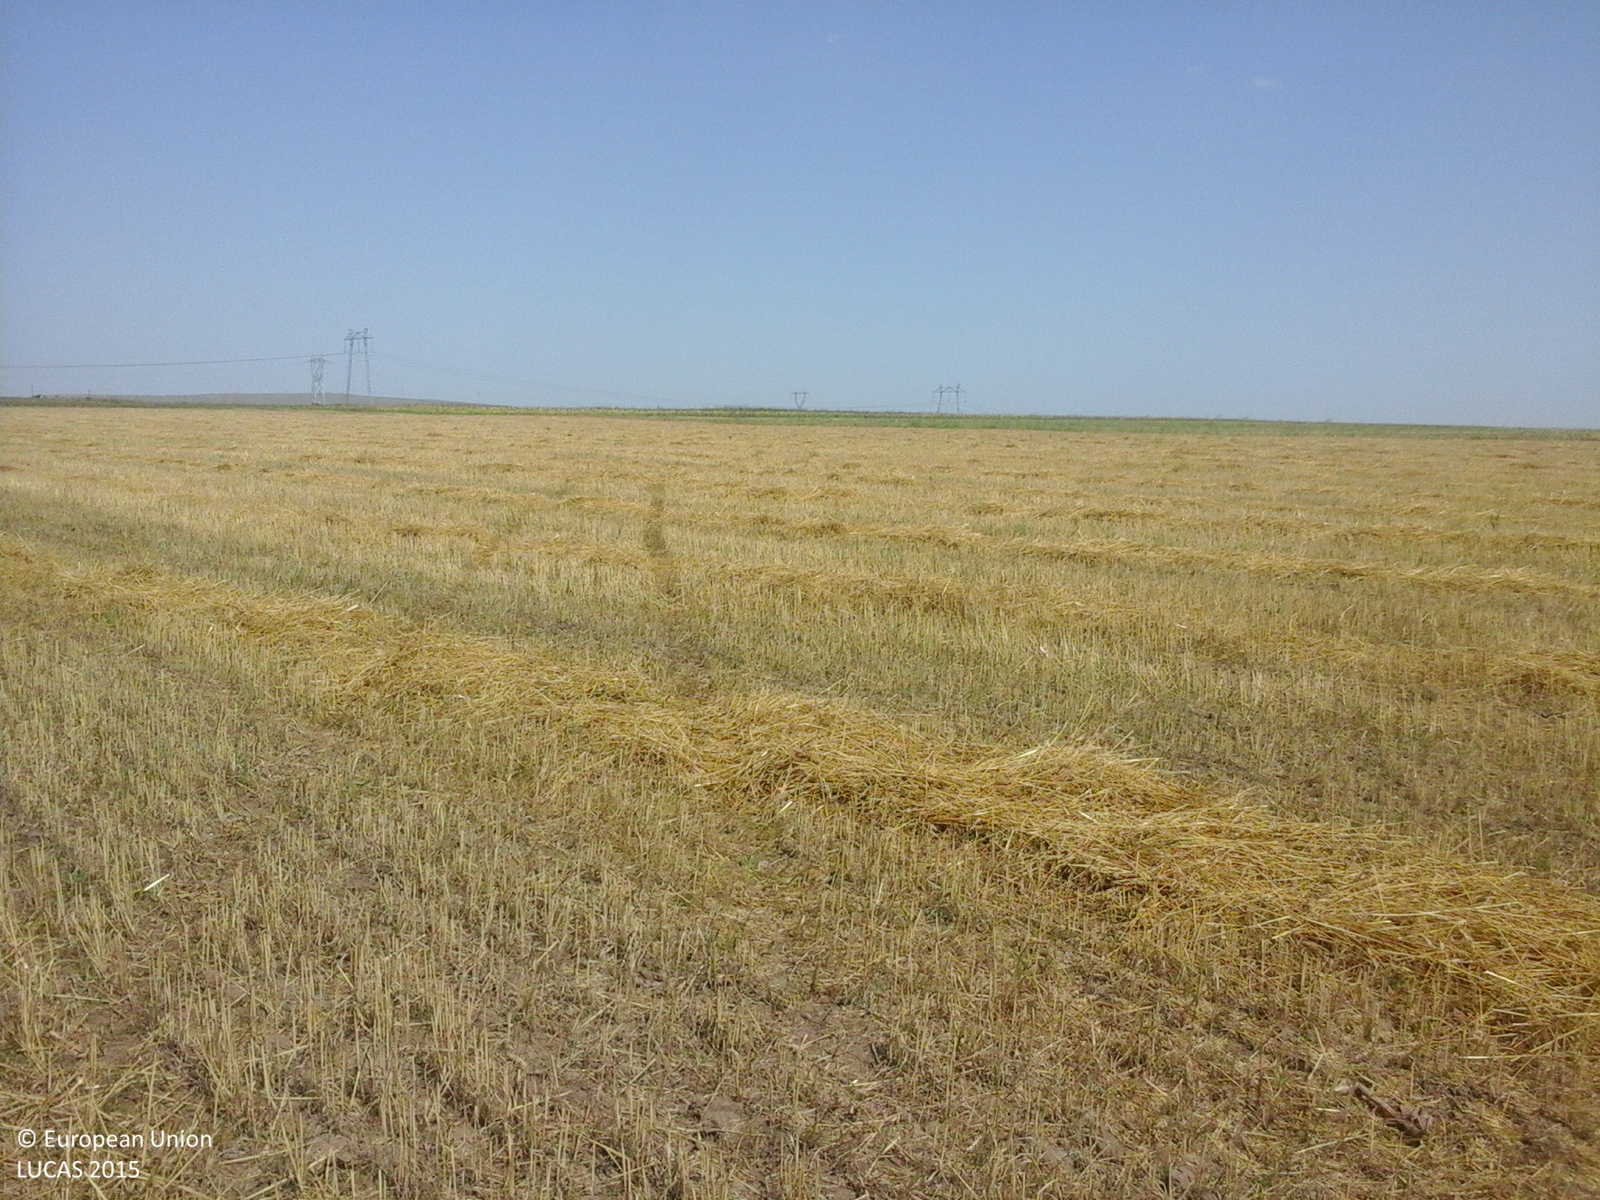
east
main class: Cropland
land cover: Common wheat
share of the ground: > 75 %
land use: Agriculture (excluding fallow land and kitchen gardens)
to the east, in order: Common wheat; Sunflower
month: August
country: RO
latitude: 44.5288
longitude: 28.1181
